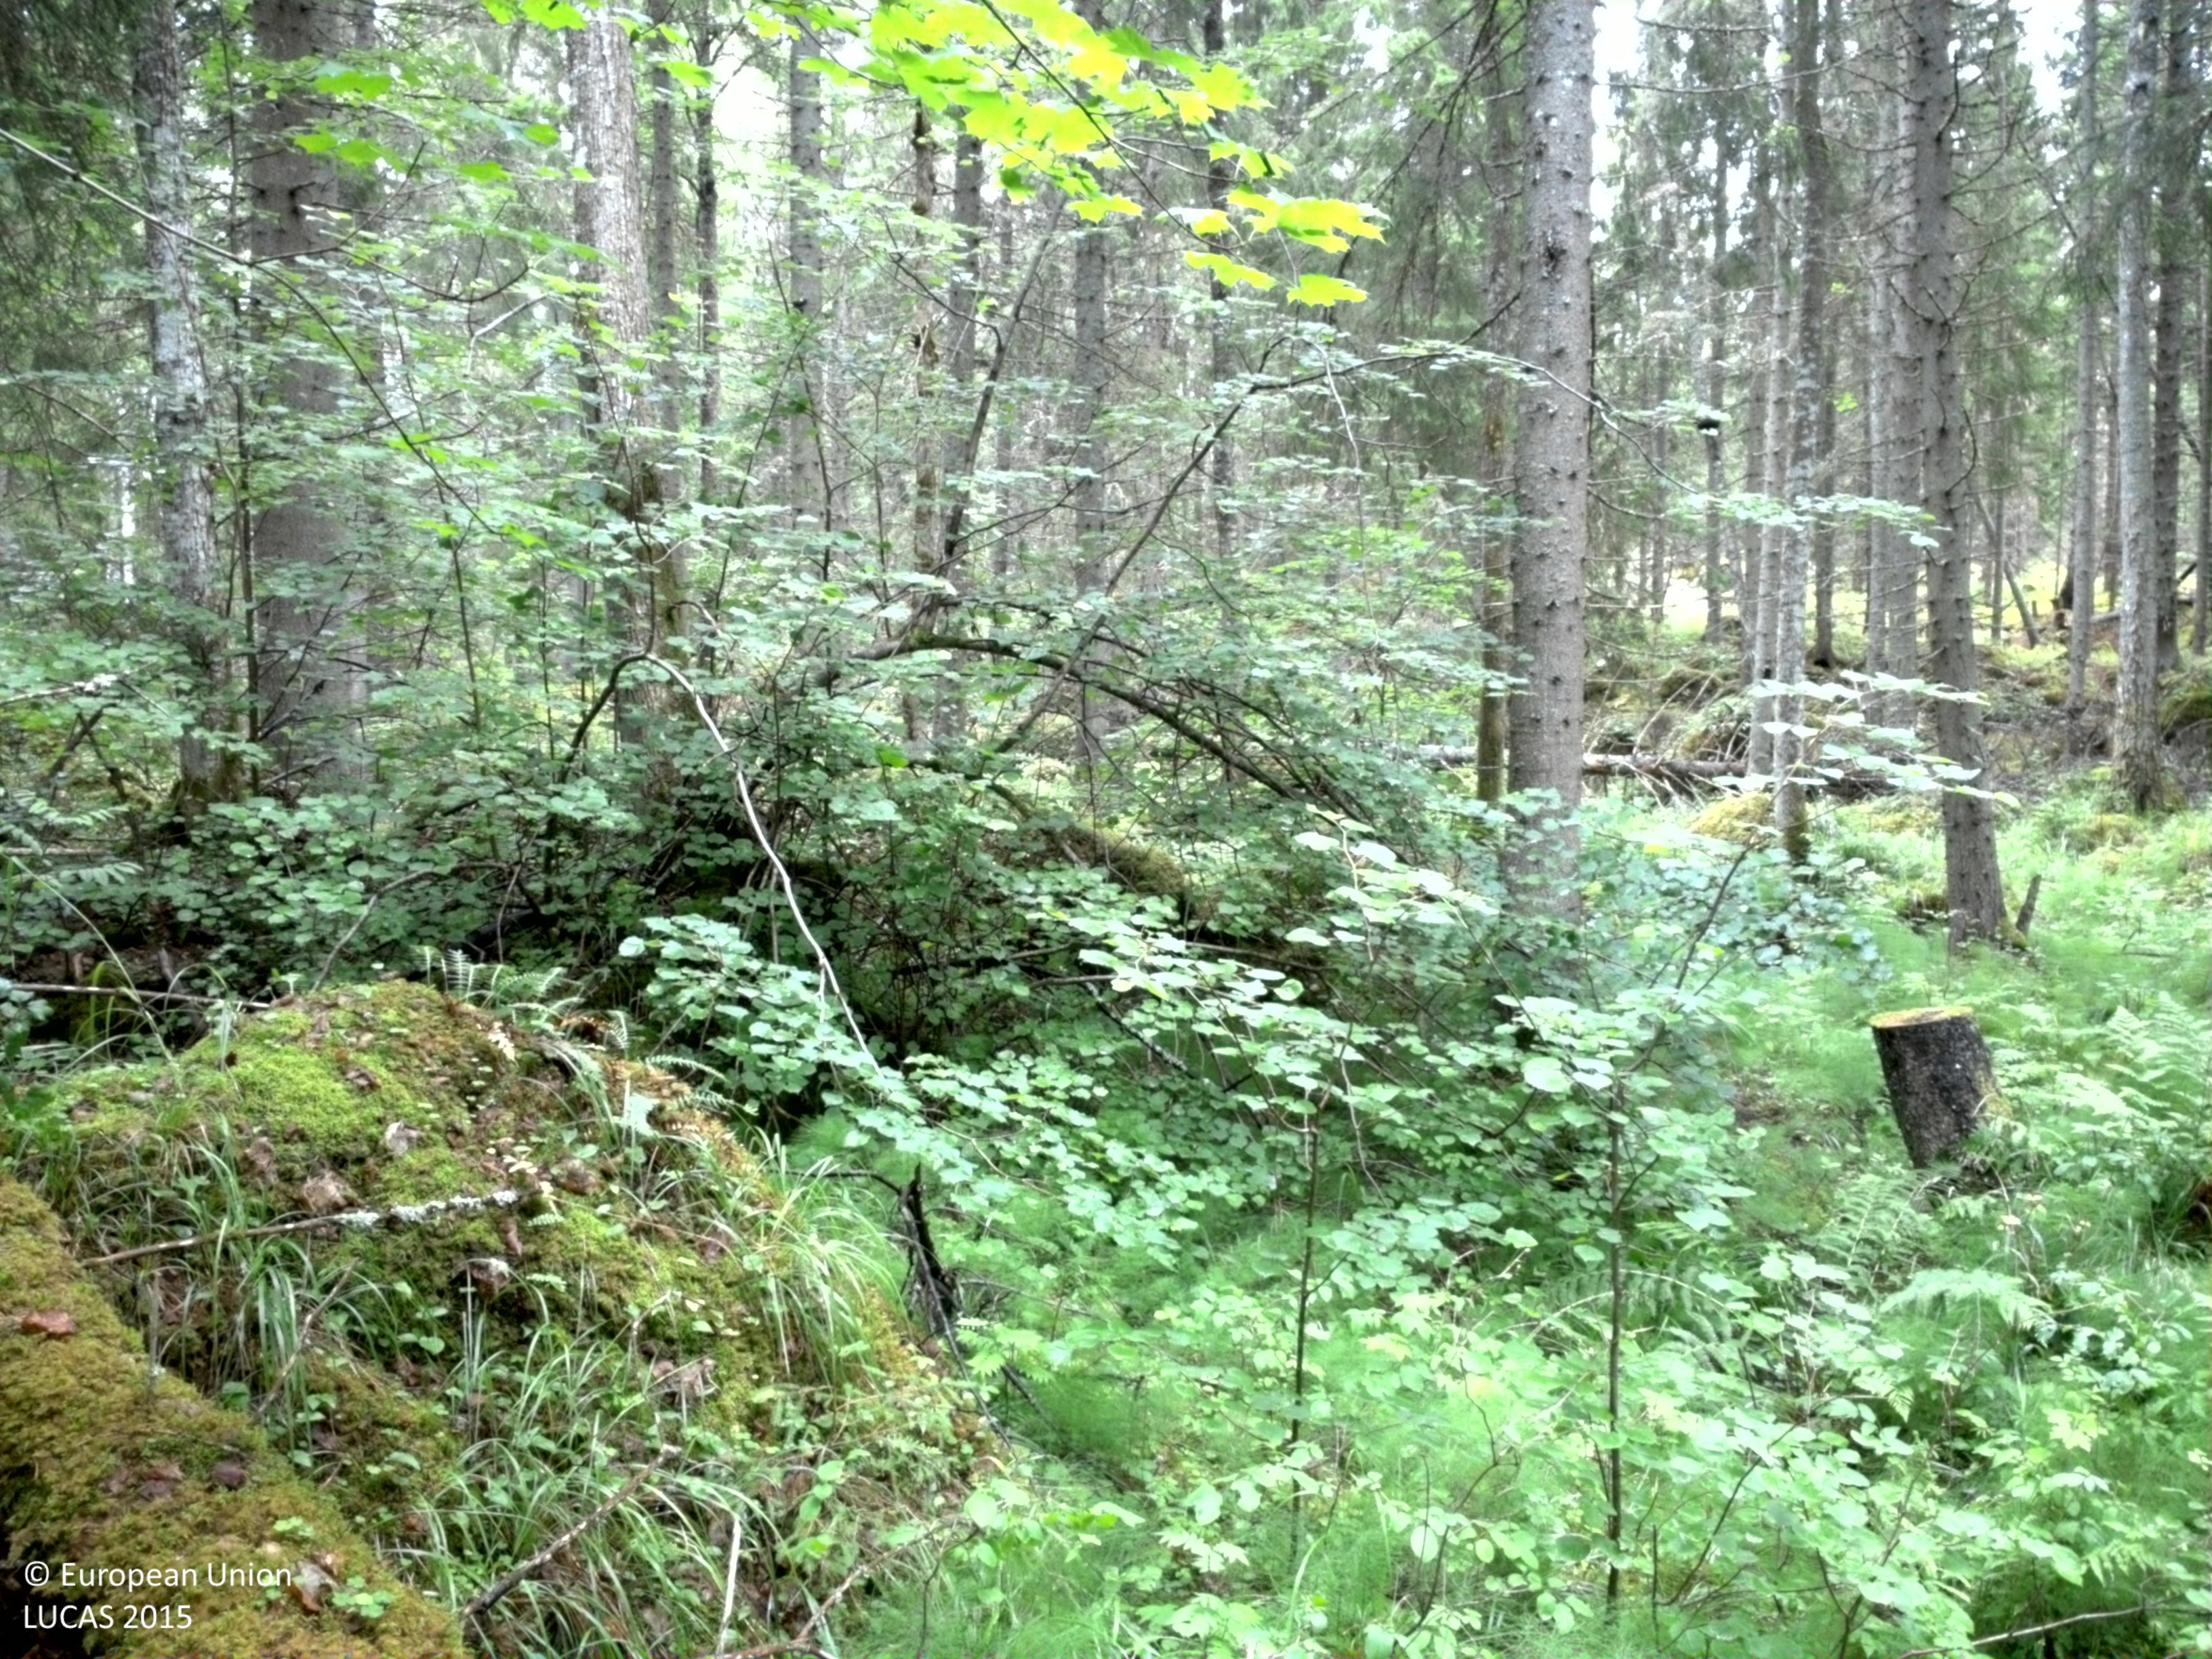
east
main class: Woodland
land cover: Spruce dominated coniferous woodland
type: boreal forest
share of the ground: > 75 %
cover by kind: coniferous forest trees 75 %, herbaceous plants 10 %, lichens and mosses 10 %, broadleaved forest trees 5 %
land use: Forestry
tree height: > 5 m
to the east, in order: Spruce dominated coniferous woodland
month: July
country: SE
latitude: 59.9485
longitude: 18.3935
